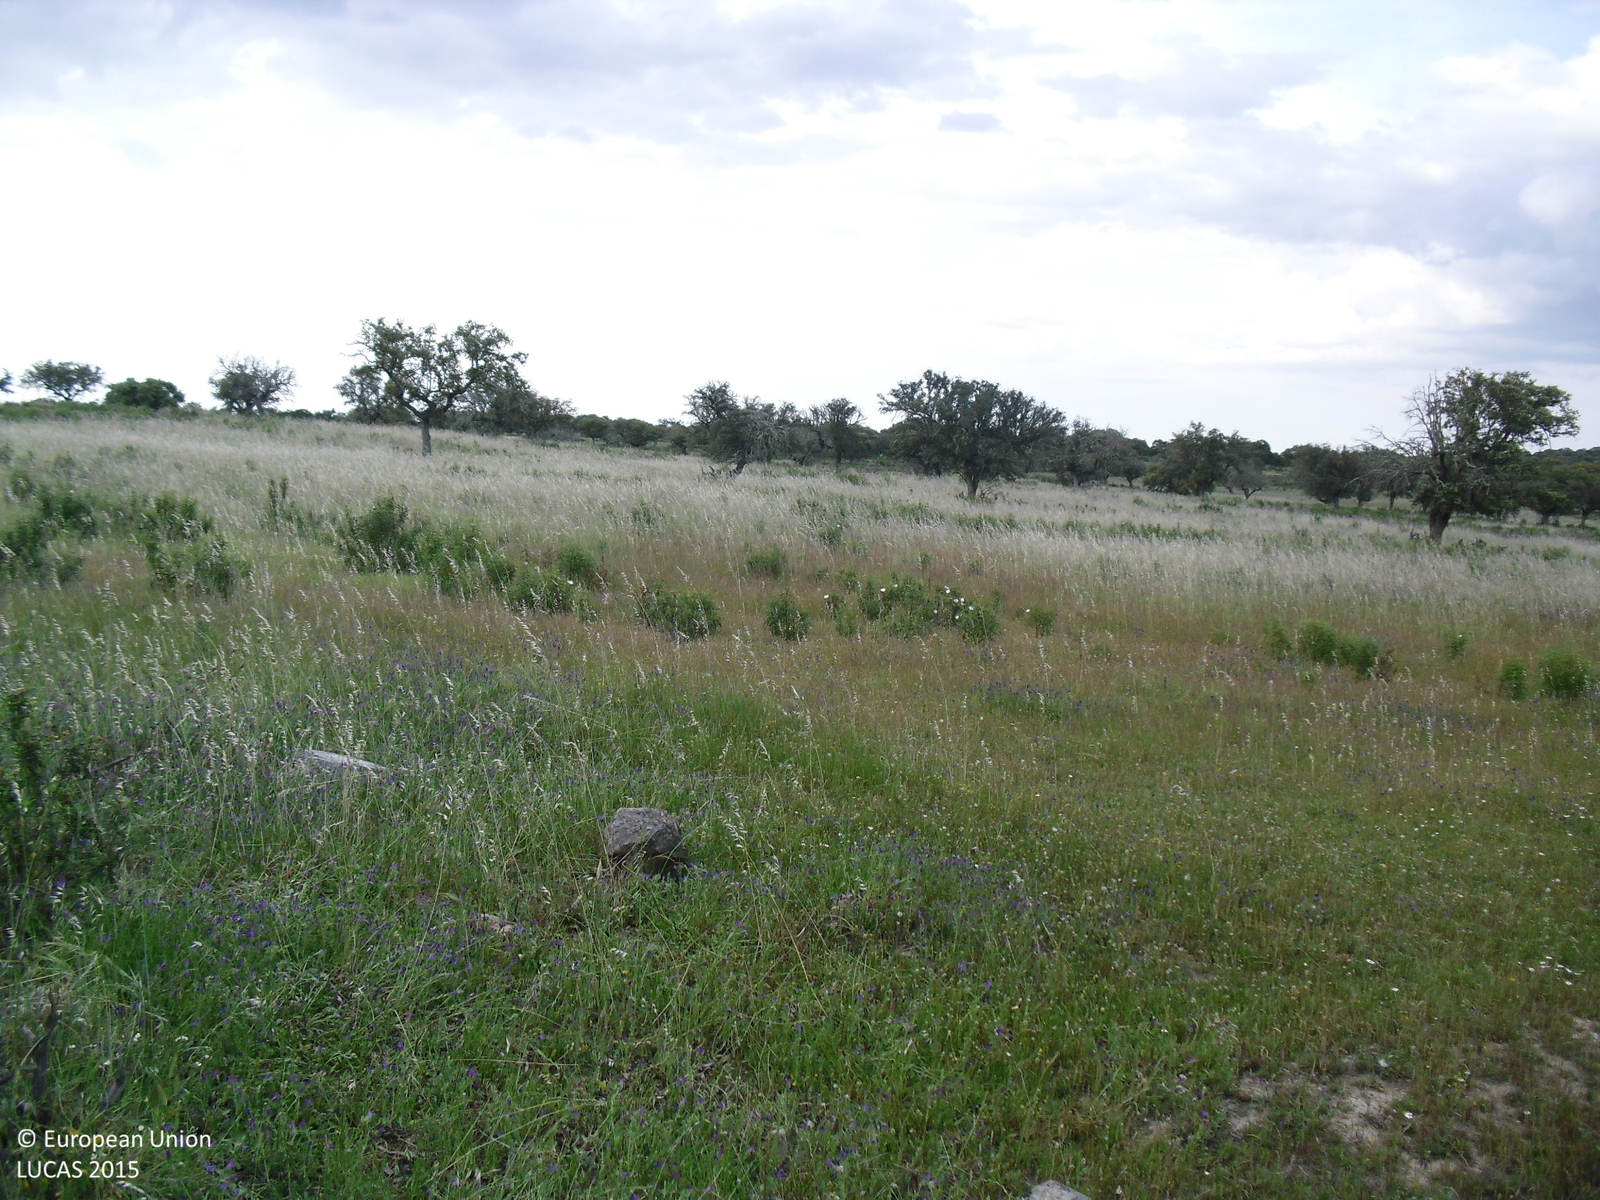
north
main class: Shrubland
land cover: Shrubland with sparse tree cover
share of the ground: > 75 %
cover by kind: shrubs 50 %, herbaceous plants 45 %, broadleaved forest trees 5 %
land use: Agriculture (excluding fallow land and kitchen gardens)
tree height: > 5 m
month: April
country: ES
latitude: 39.4271
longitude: -6.6263
